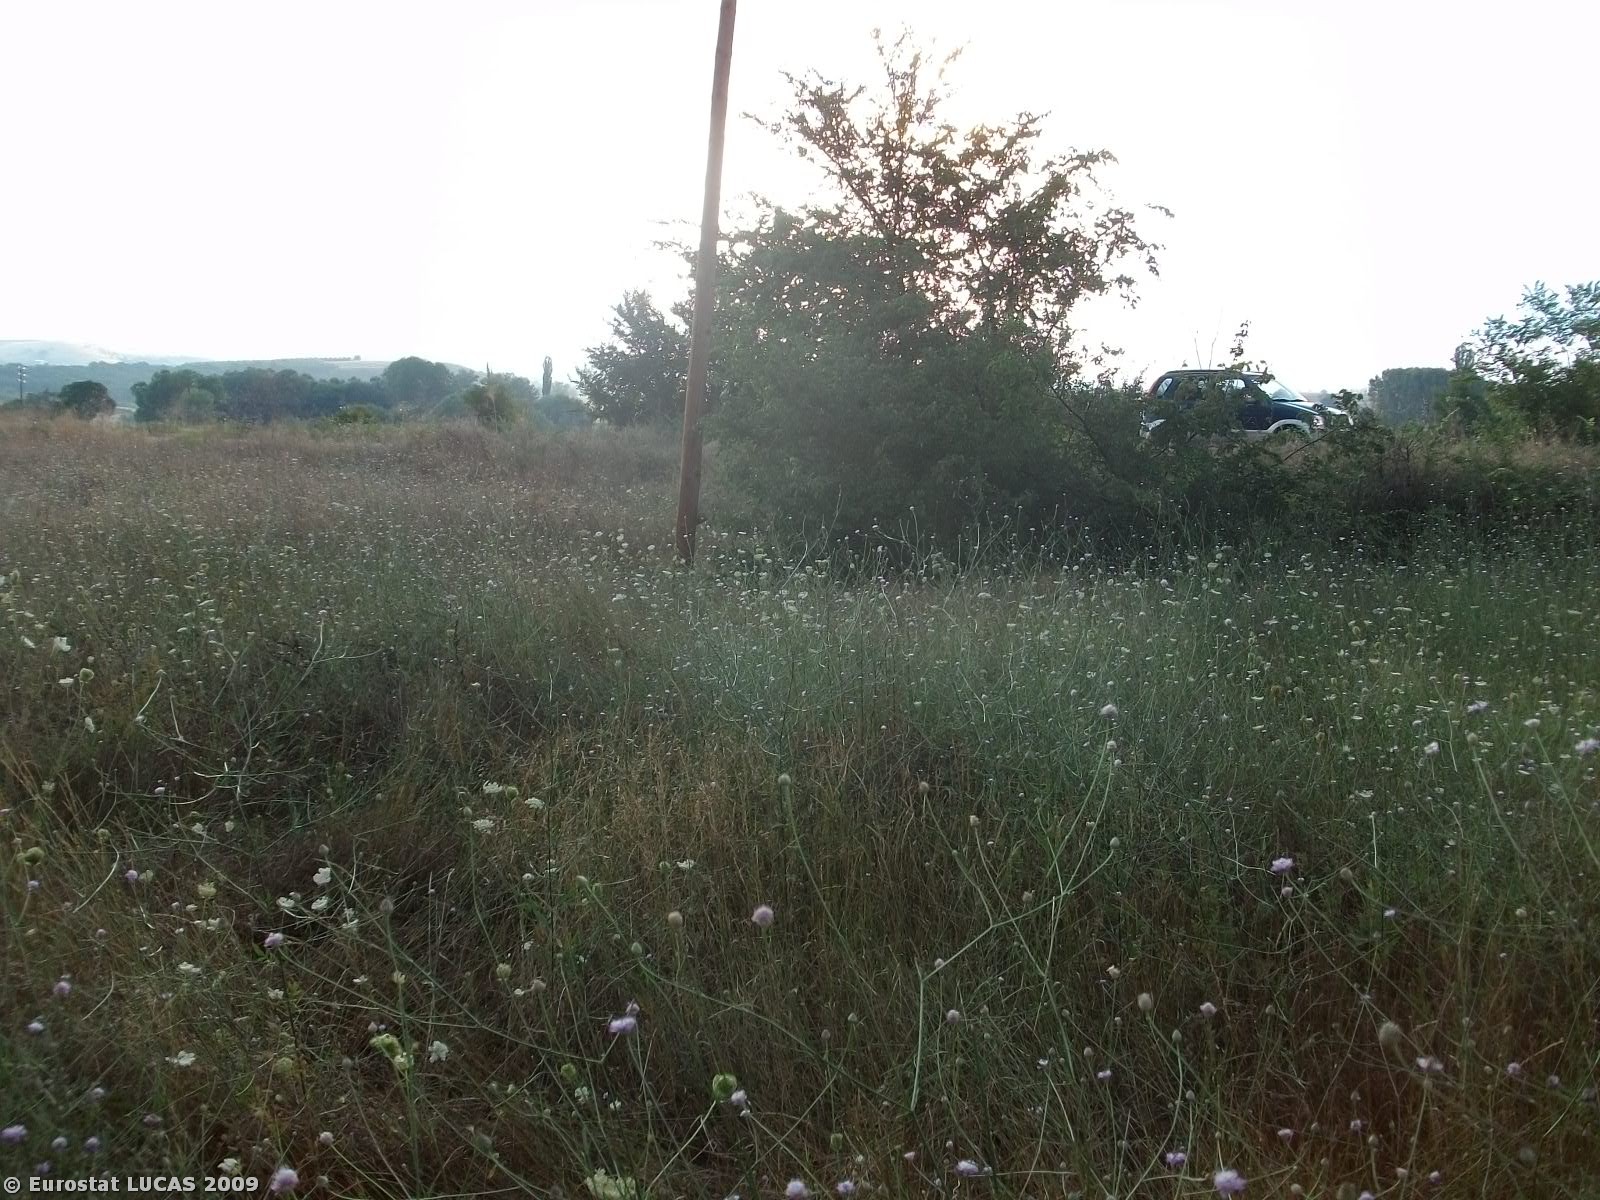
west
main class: Grassland
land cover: Grassland without tree/shrub cover
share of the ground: > 75 %
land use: Unused
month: August
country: GR
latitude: 41.3631
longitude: 26.3920
